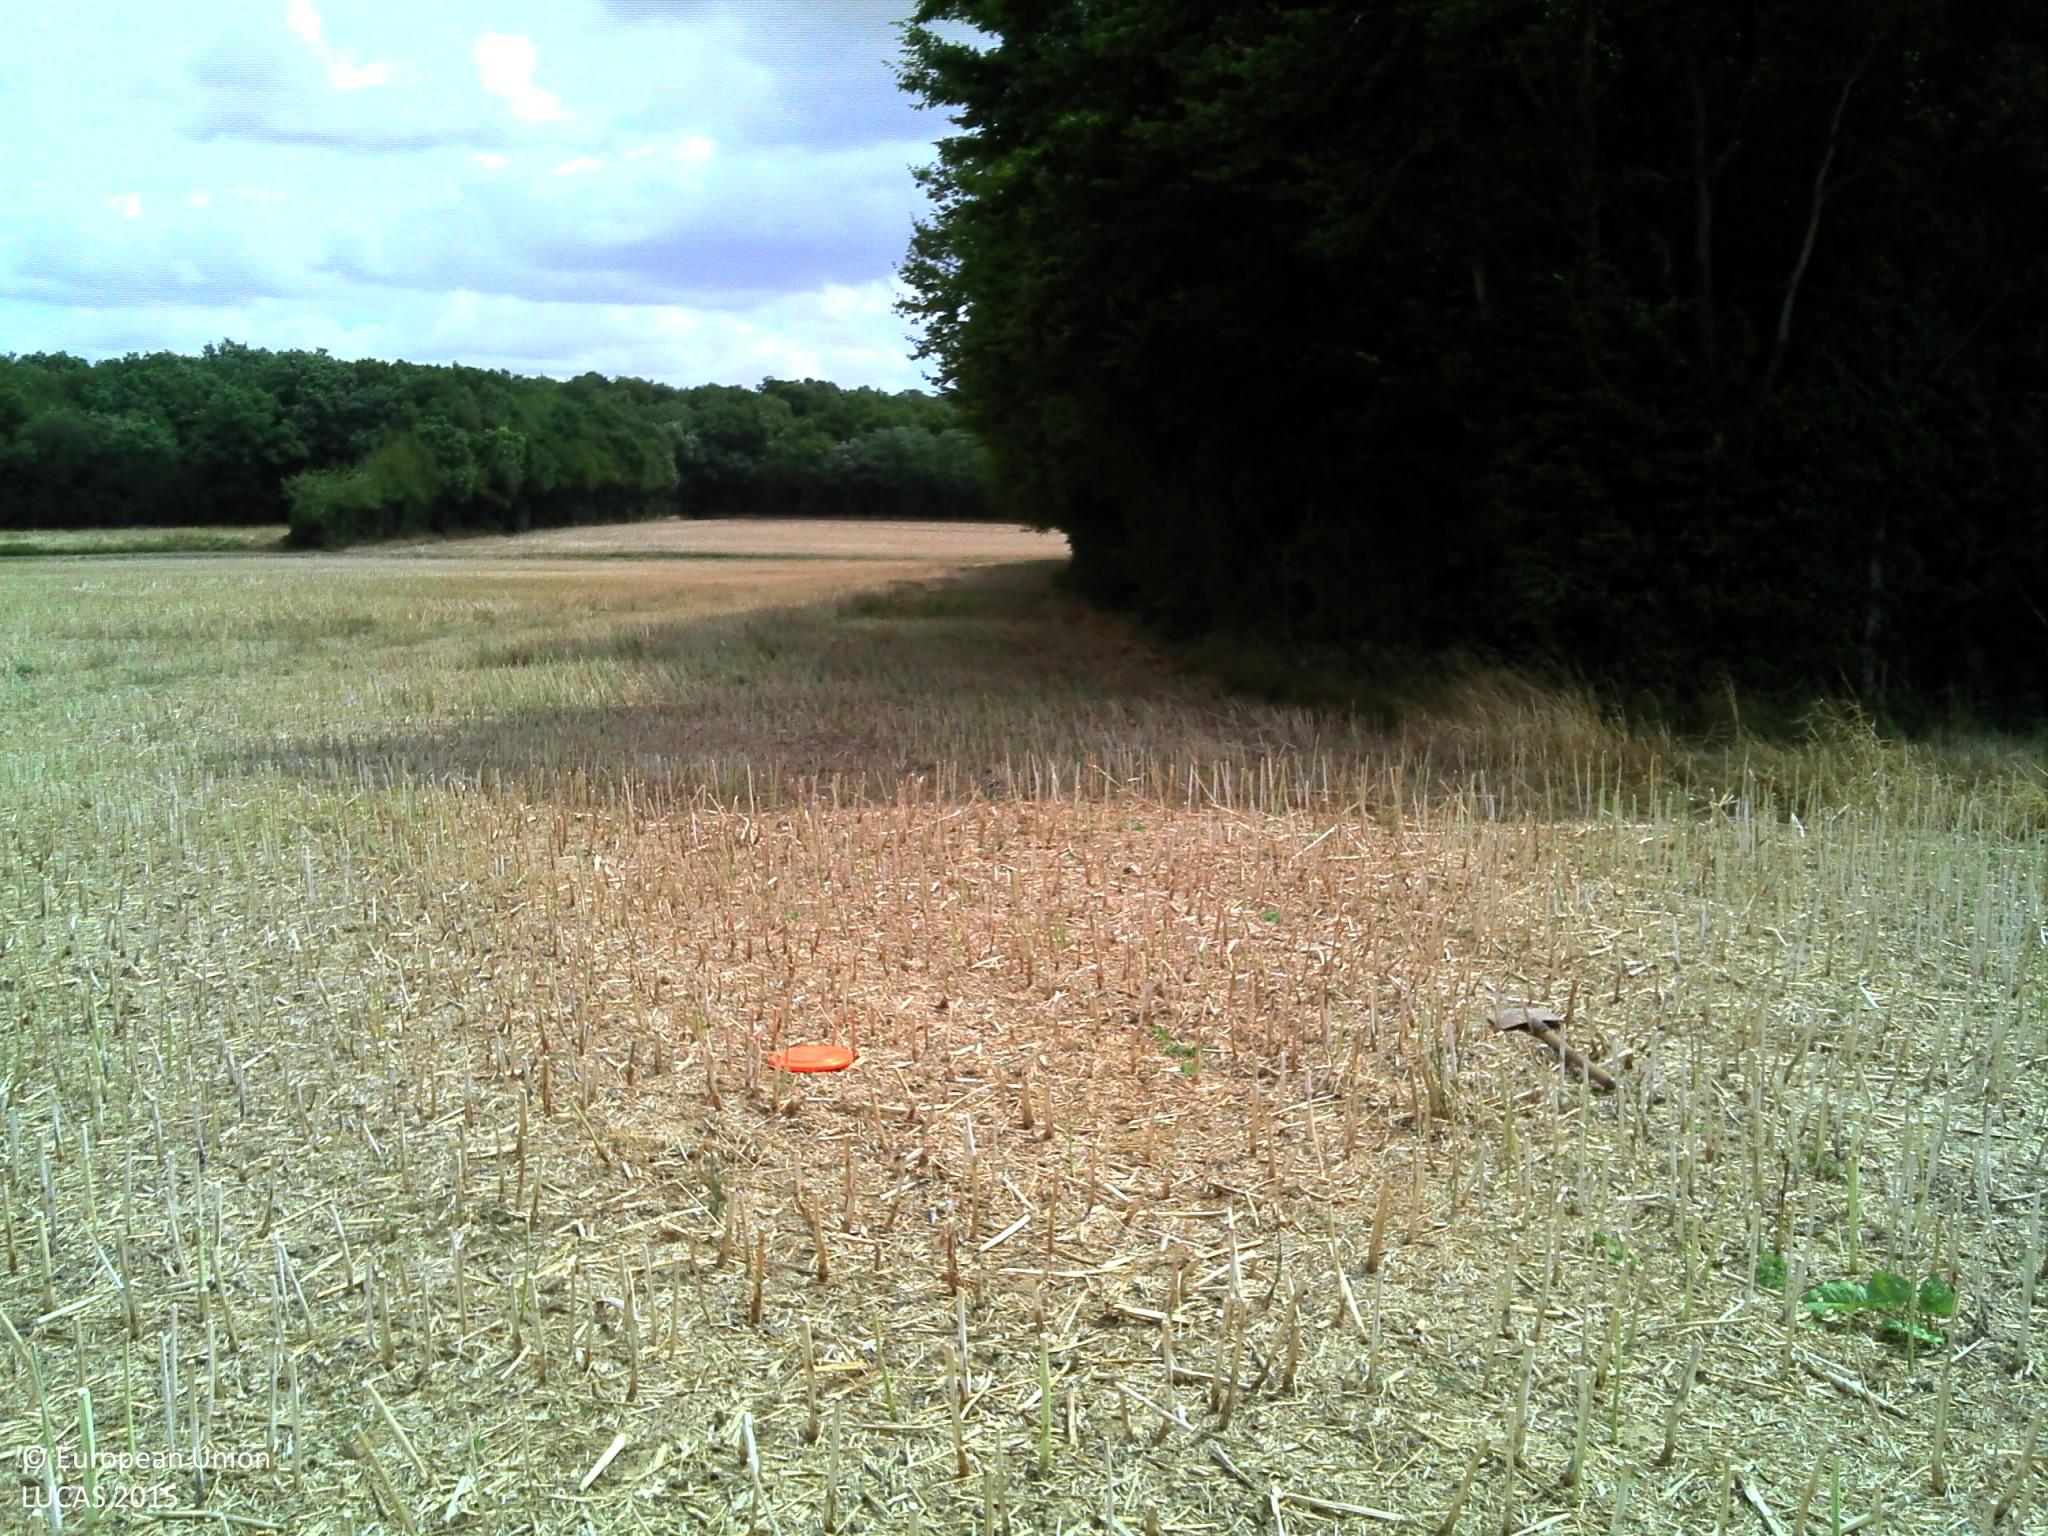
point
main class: Cropland
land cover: Rape and turnip rape
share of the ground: > 75 %
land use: Agriculture (excluding fallow land and kitchen gardens)
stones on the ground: < 10 %
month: July
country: FR
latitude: 47.8779
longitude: 3.0538
